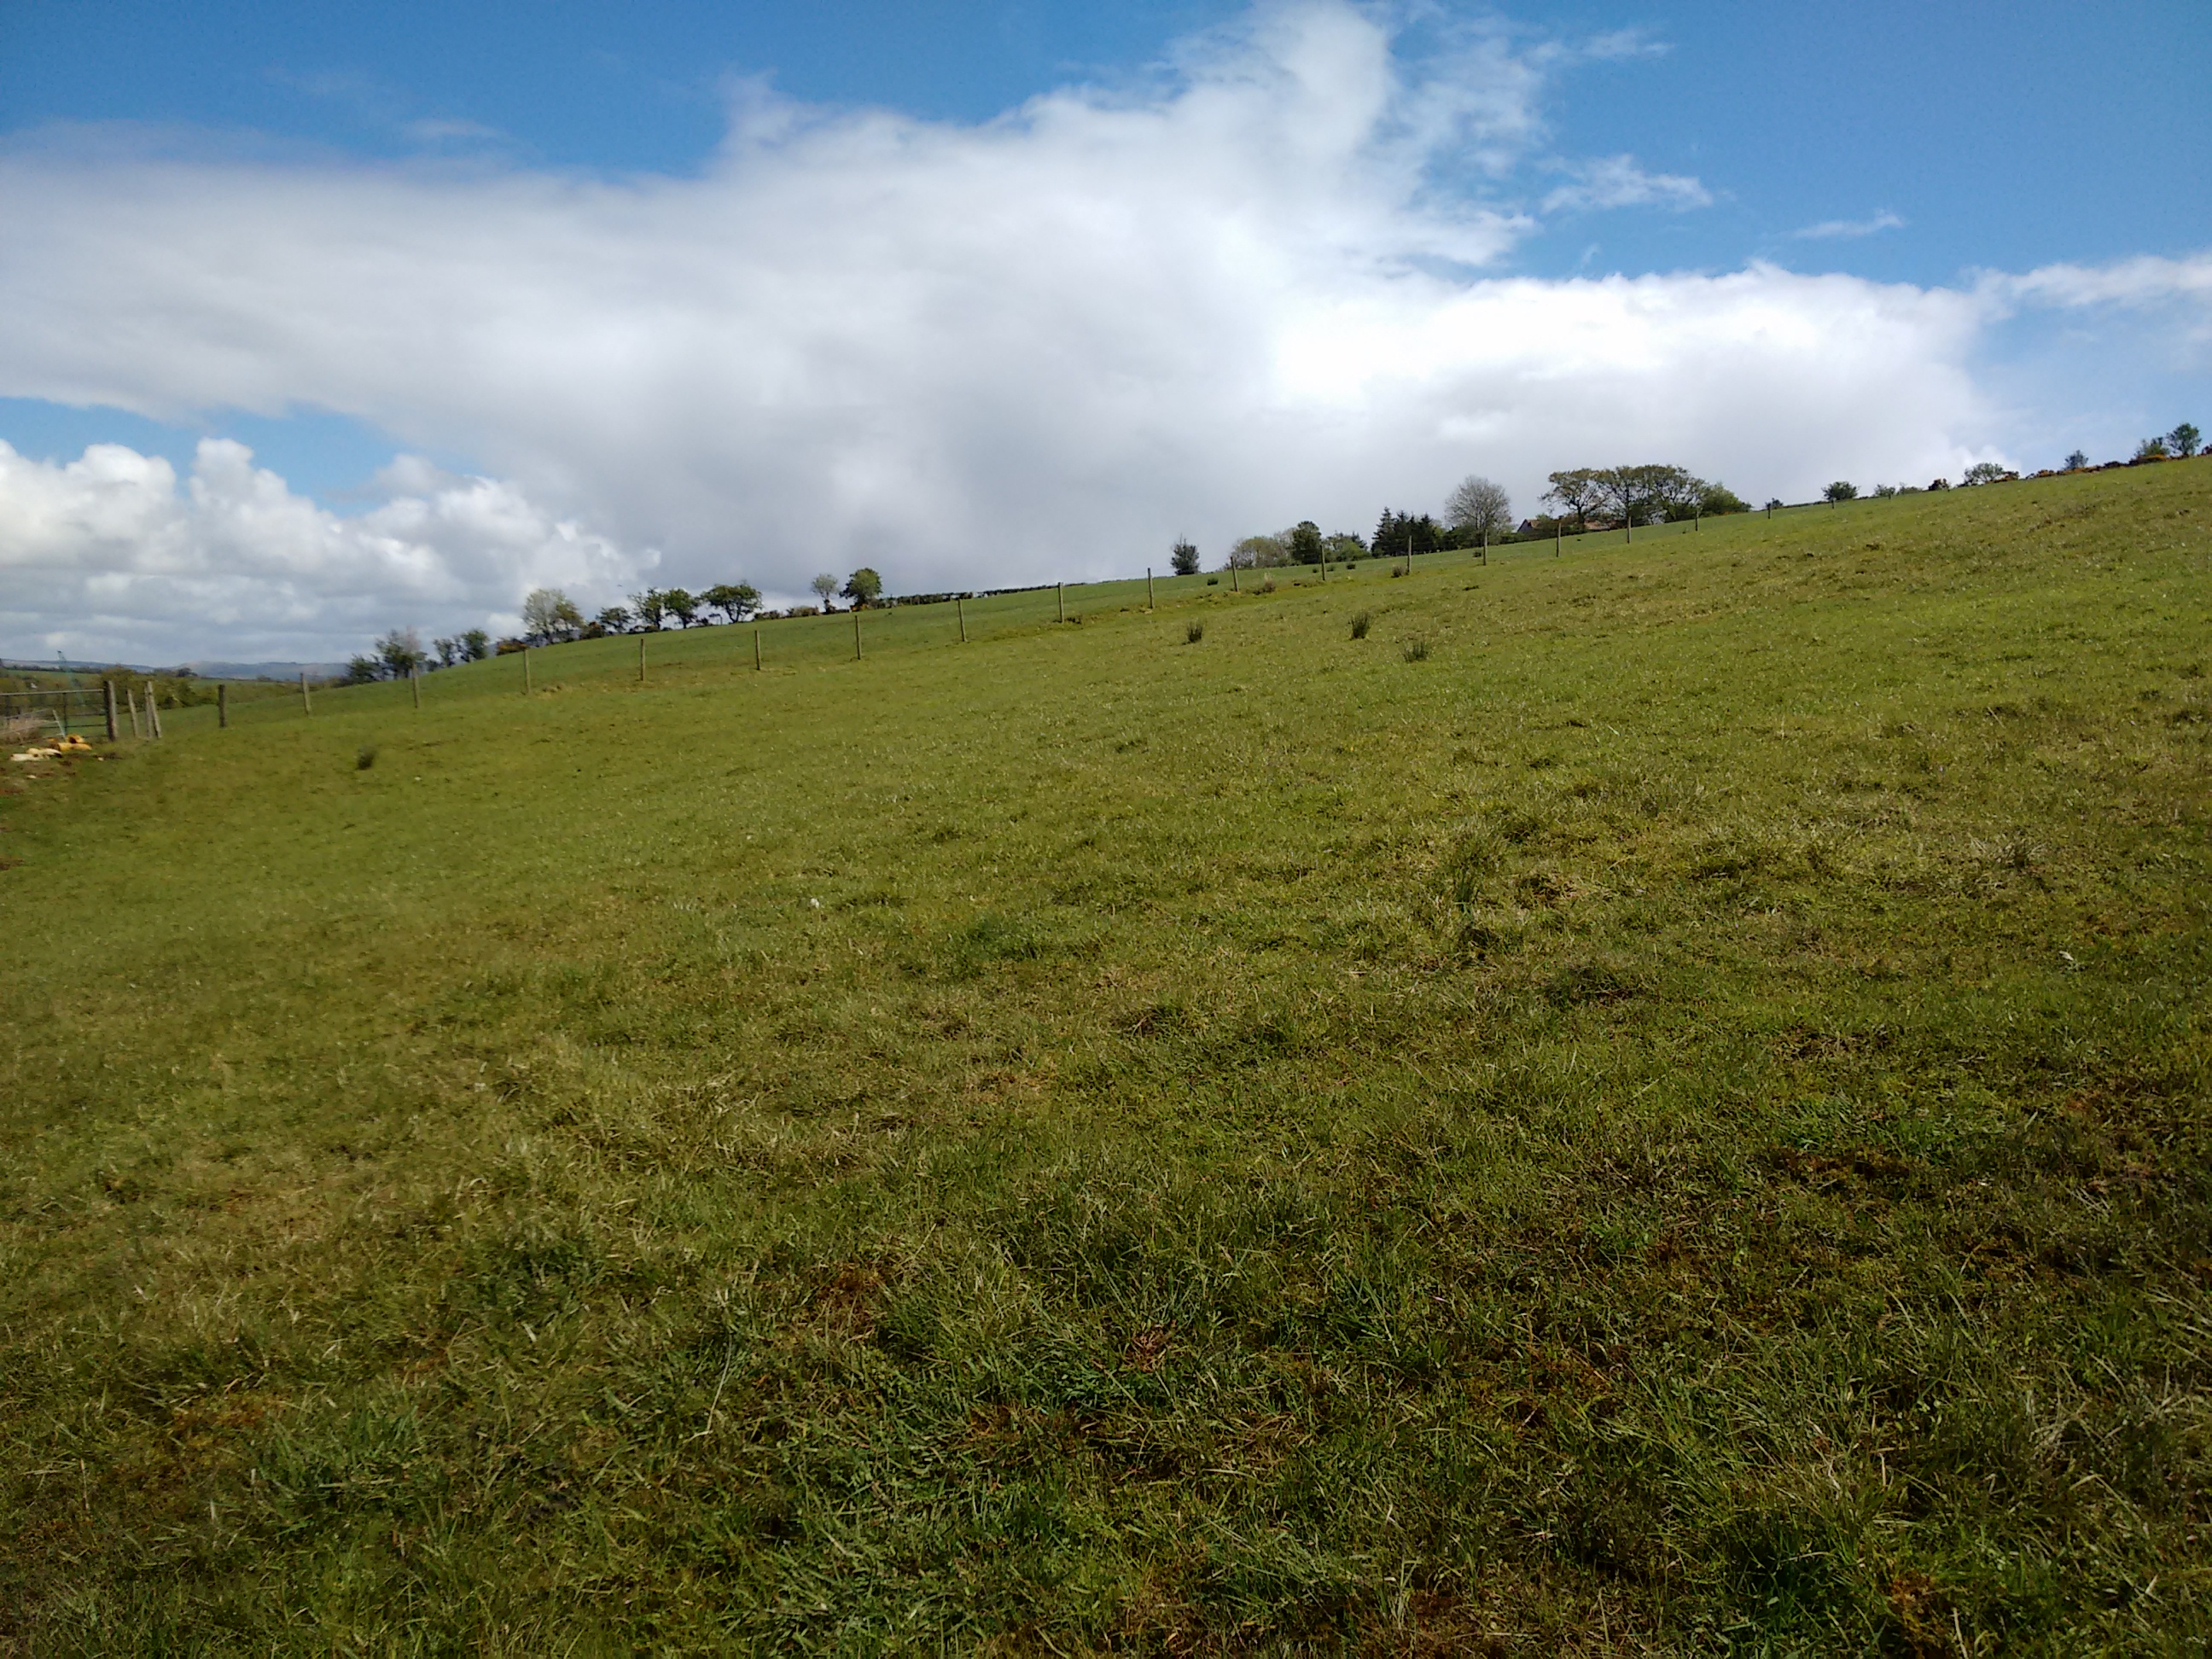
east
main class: Grassland
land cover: Grassland without tree/shrub cover
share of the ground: > 75 %
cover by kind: herbaceous plants 100 %
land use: Agriculture (excluding fallow land and kitchen gardens)
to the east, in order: Grassland without tree/shrub cover; Fences; Grassland without tree/shrub cover; Fences; Managed hedges; Grassland without tree/shrub cover
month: May
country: GB
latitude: 54.9246
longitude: -7.0382
